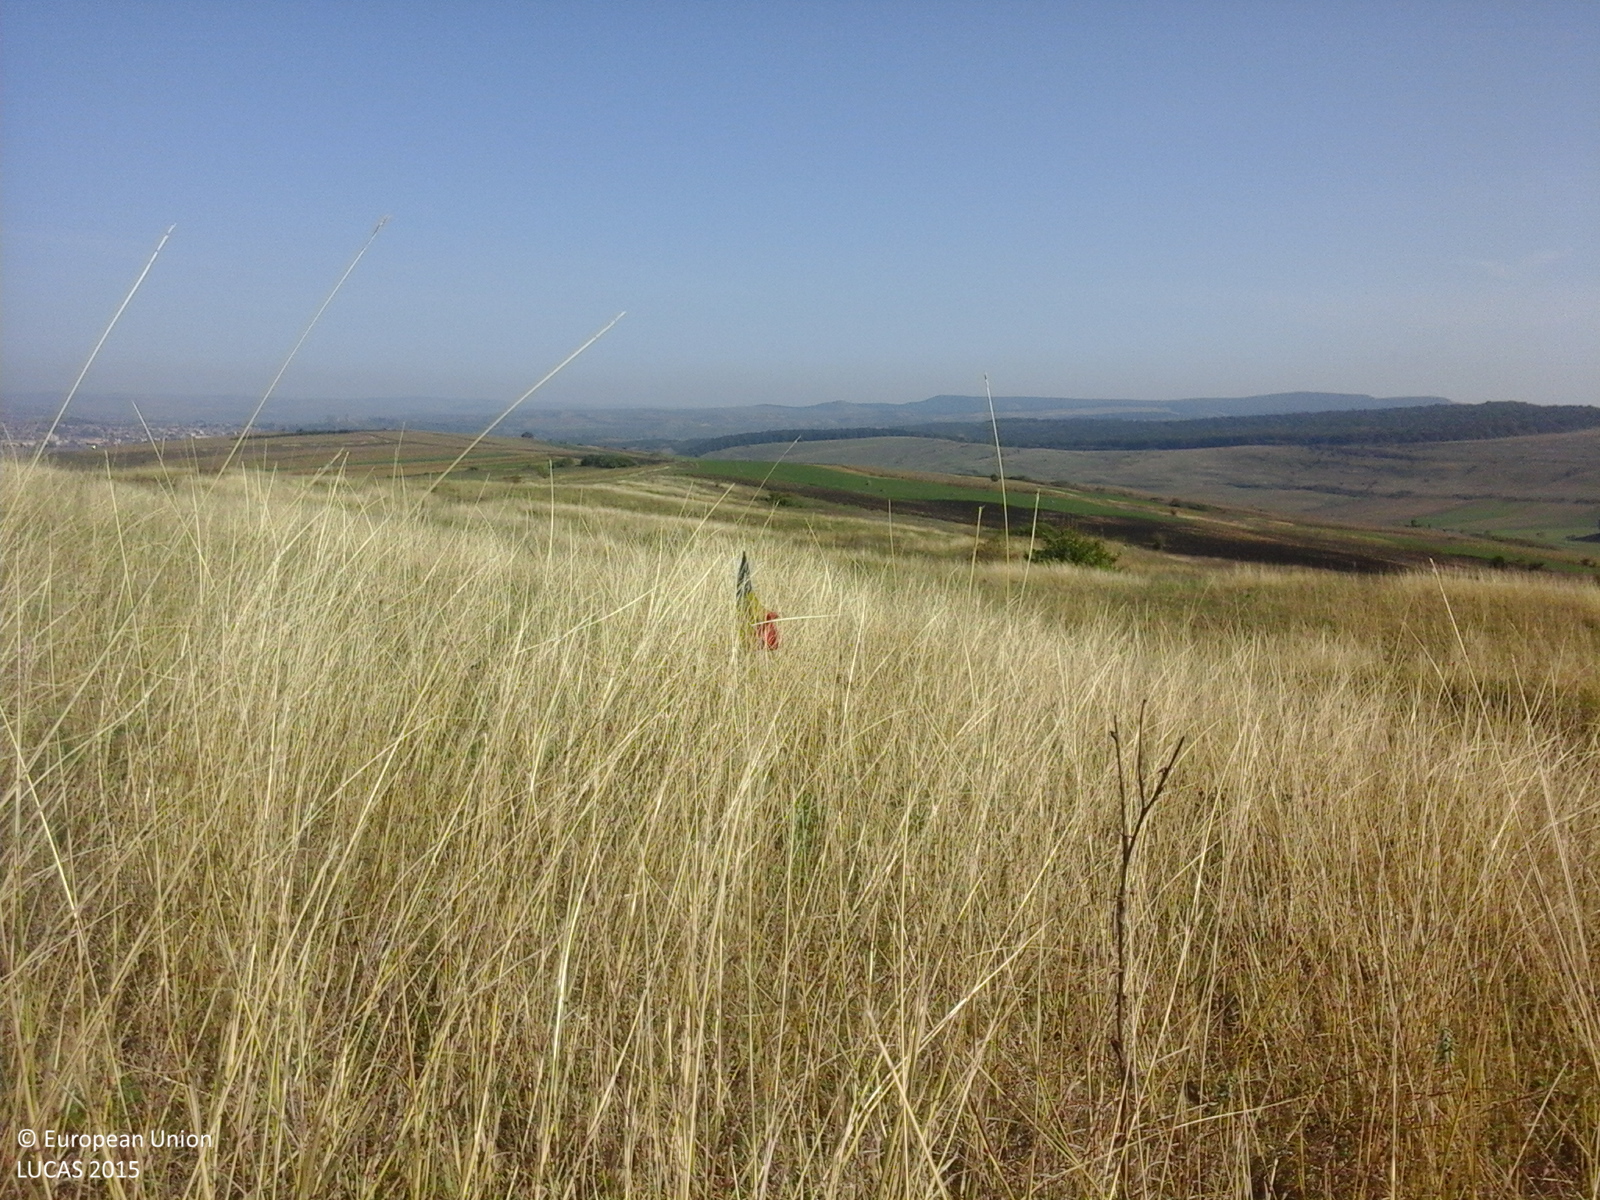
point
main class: Grassland
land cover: Grassland without tree/shrub cover
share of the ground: > 75 %
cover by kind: herbaceous plants 100 %
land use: Agriculture (excluding fallow land and kitchen gardens)
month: October
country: RO
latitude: 46.1346
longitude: 23.8833
